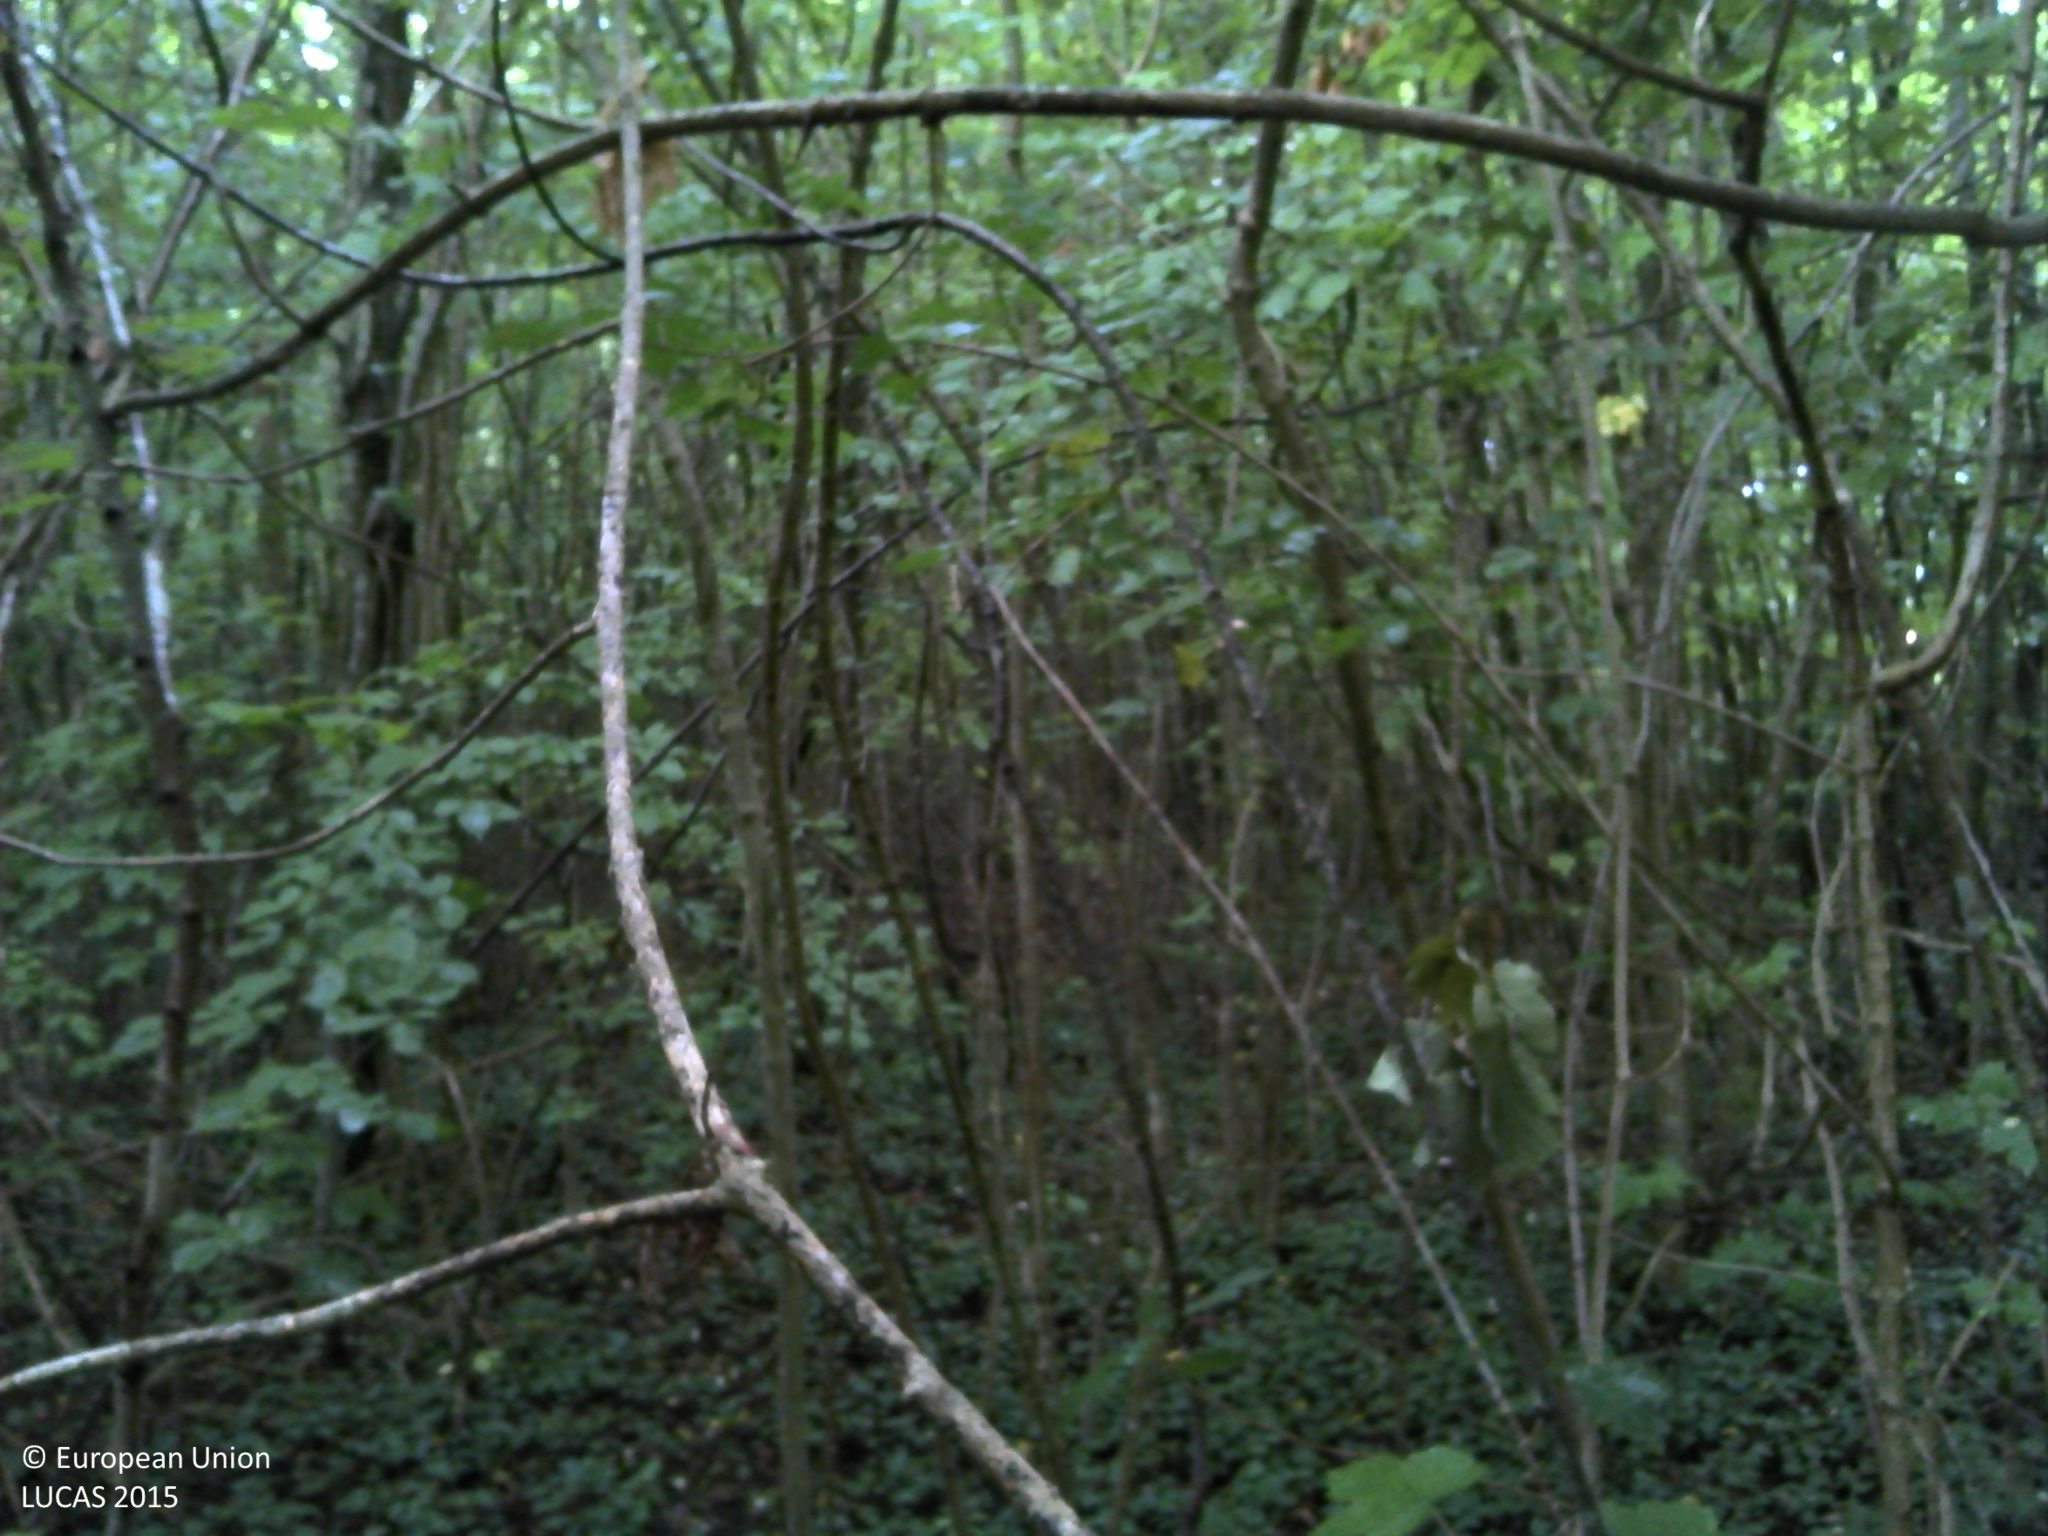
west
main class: Woodland
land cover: Broadleaved woodland
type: beech forest
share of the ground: > 75 %
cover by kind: broadleaved forest trees 75 %, herbaceous plants 15 %, consolidated bare surface 10 %
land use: Forestry
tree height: > 5 m
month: July
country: FR
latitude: 49.6794
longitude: 4.6331
